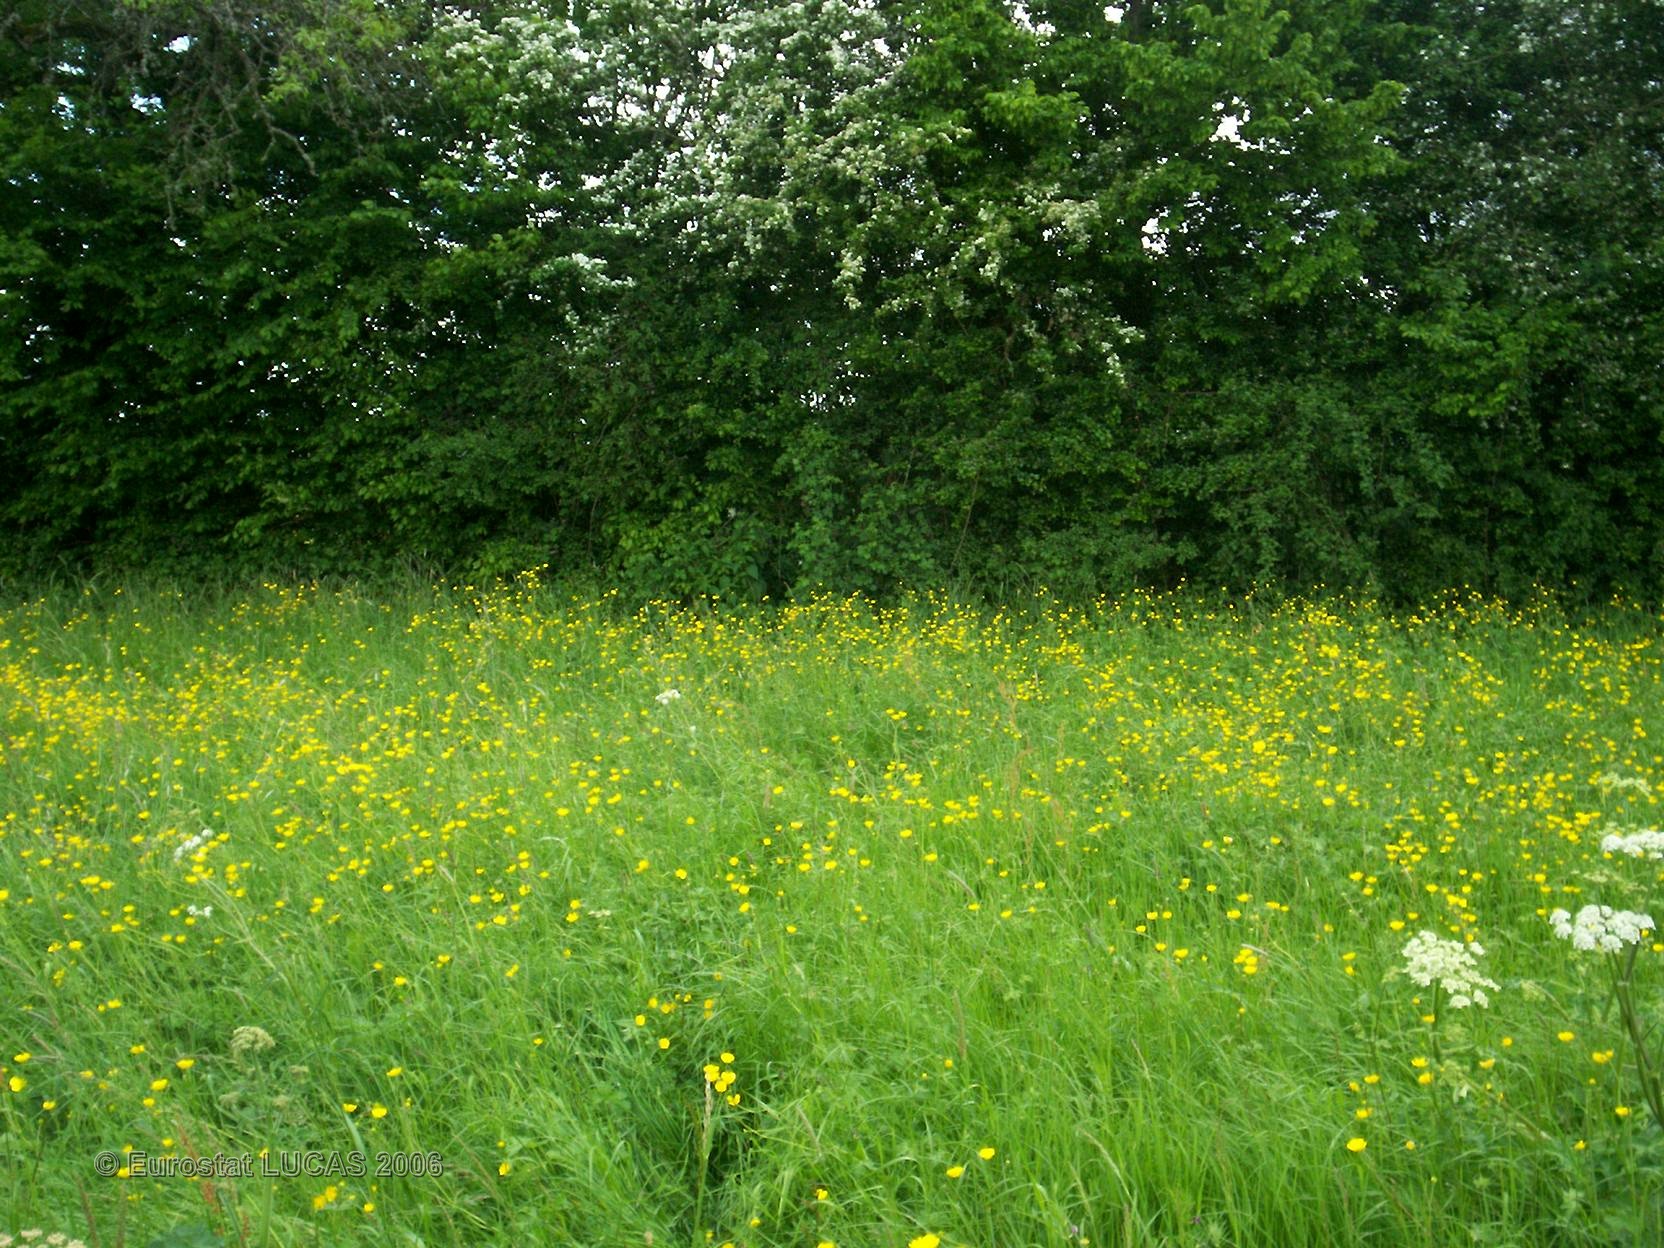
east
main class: Grassland
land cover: Grassland without tree/shrub cover
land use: Agriculture (excluding fallow land and kitchen gardens)
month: May
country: FR
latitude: 47.0804
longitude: 4.5869
